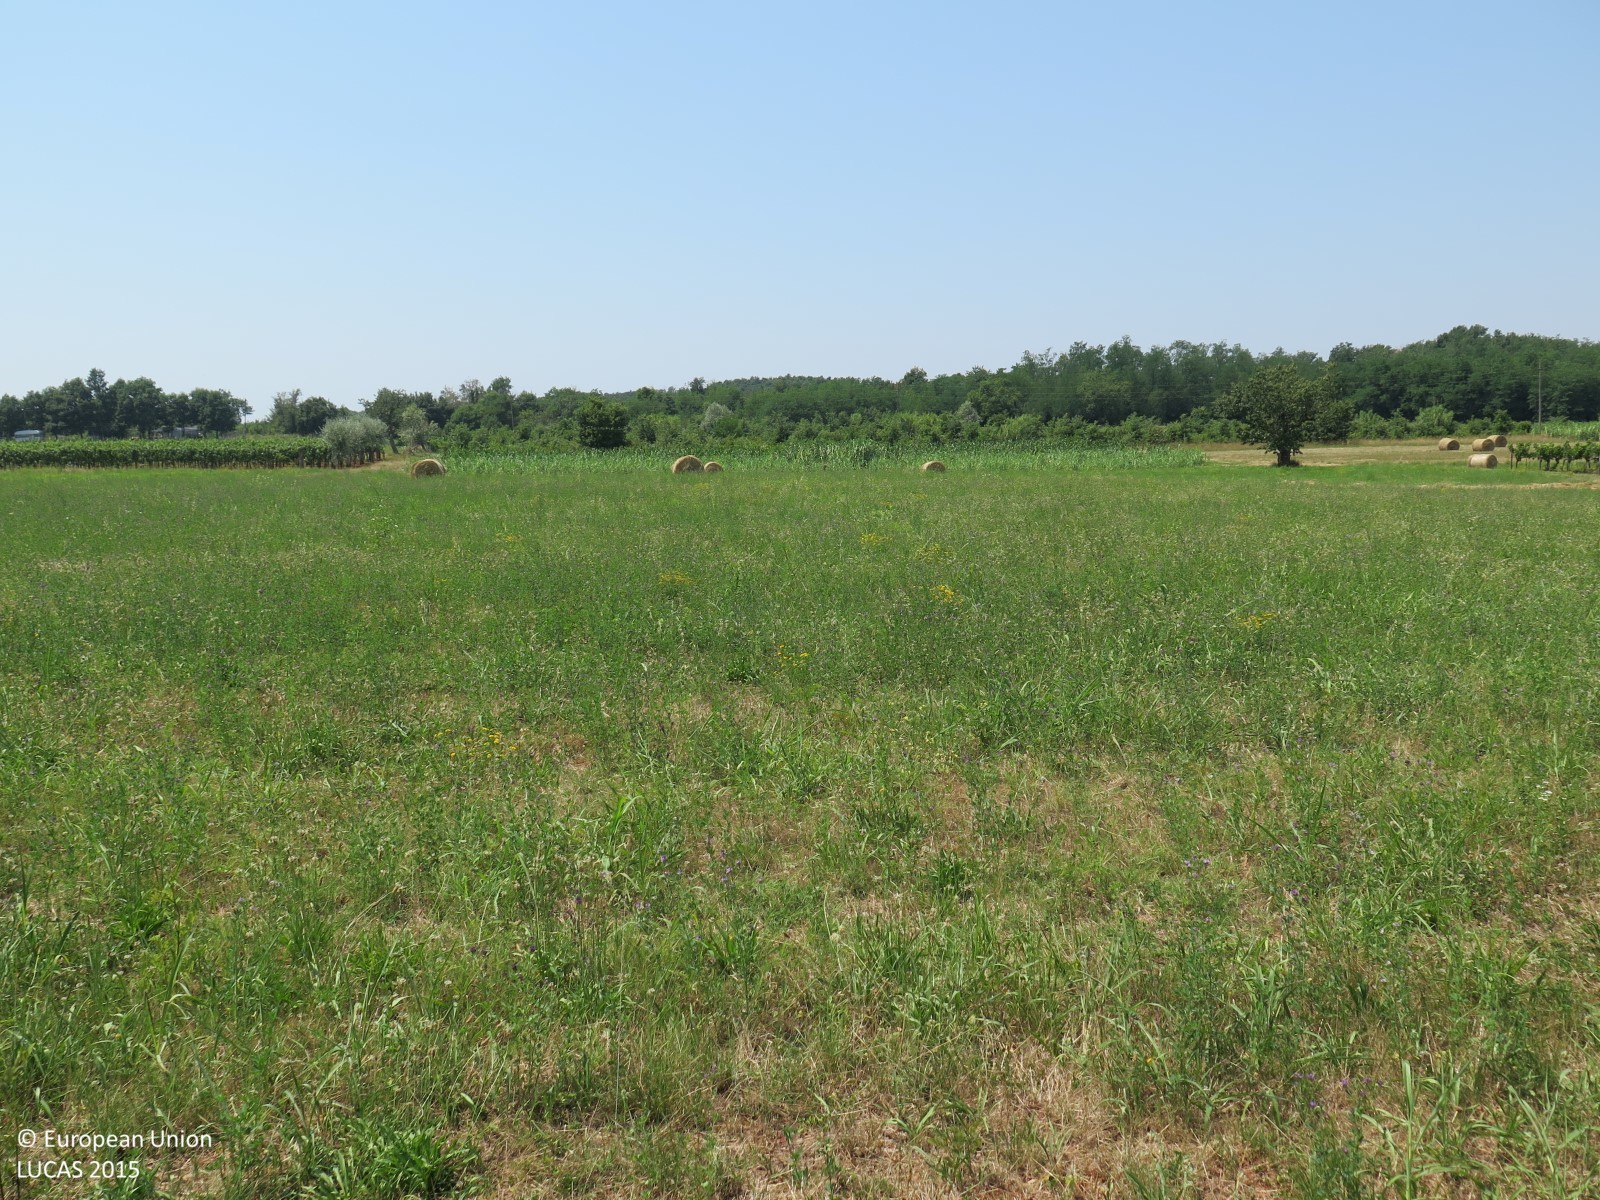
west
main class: Cropland
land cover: Temporary grasslands
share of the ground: > 75 %
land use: Agriculture (excluding fallow land and kitchen gardens)
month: July
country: HR
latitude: 45.4075
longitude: 13.5855
